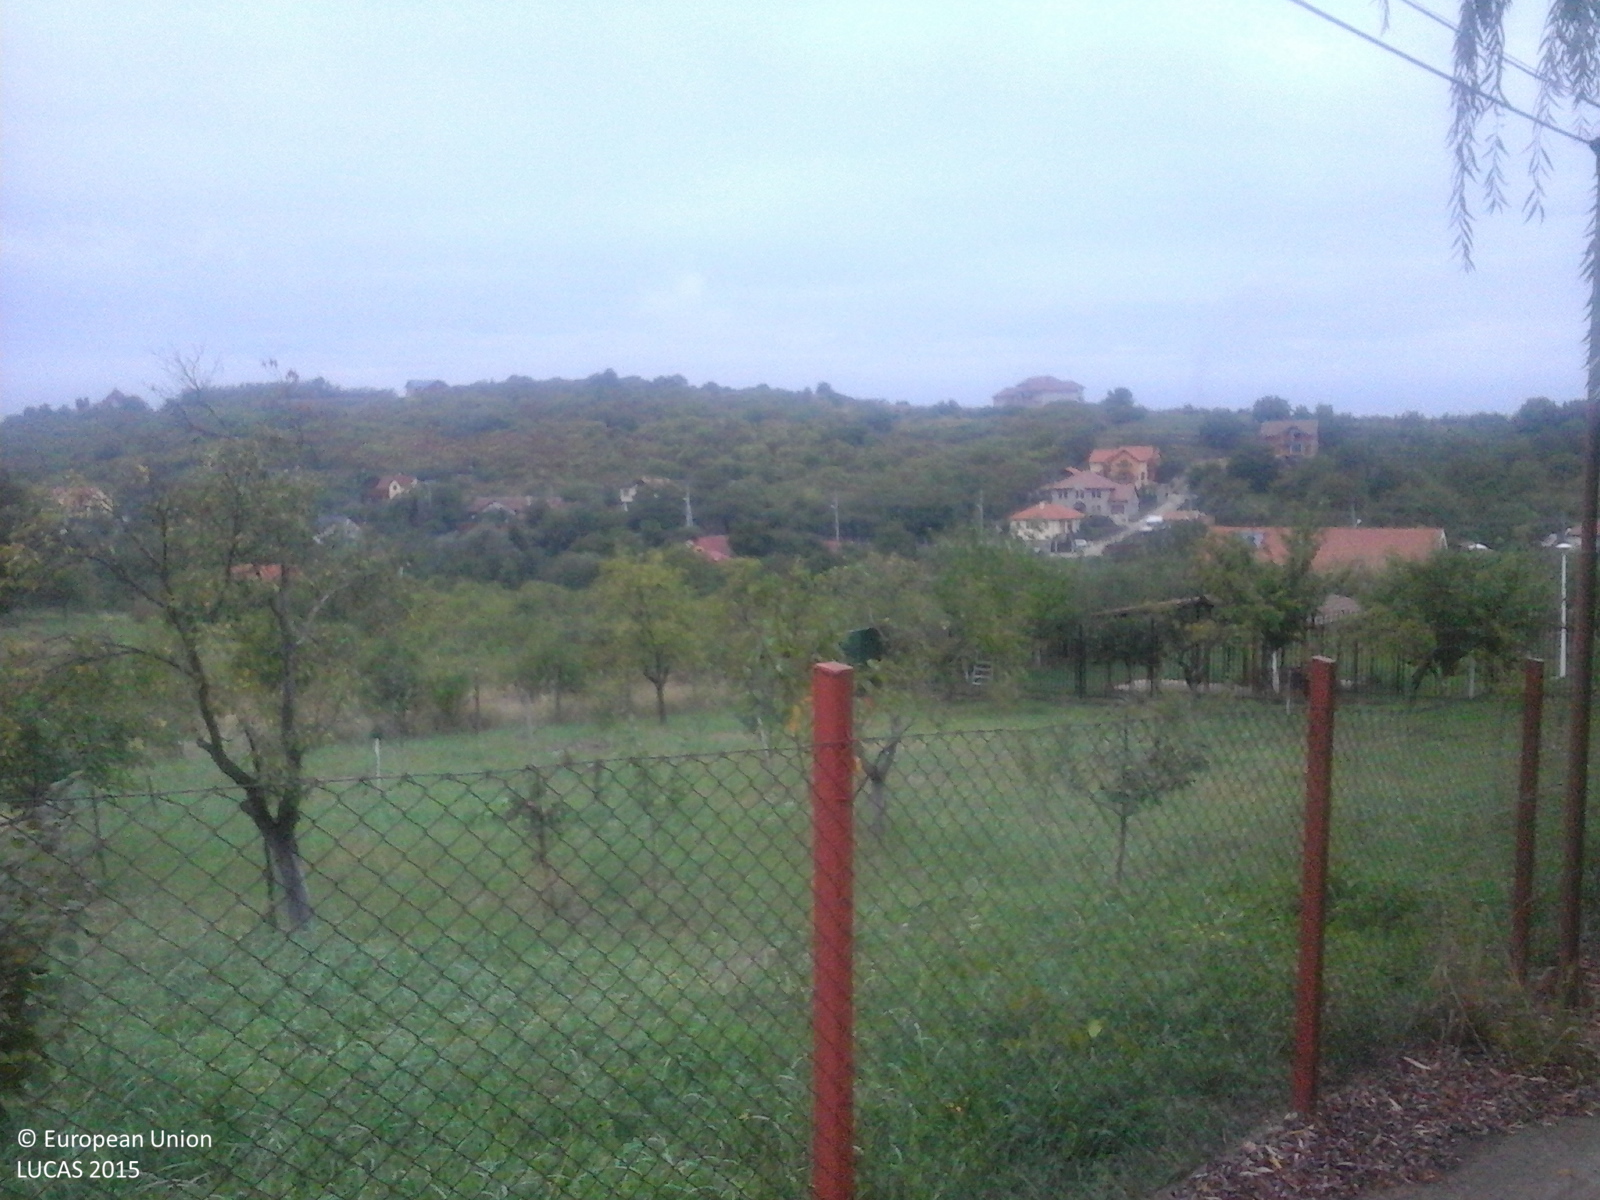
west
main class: Grassland
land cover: Spontaneously vegetated surfaces
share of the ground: > 75 %
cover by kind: herbaceous plants 100 %
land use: Residential
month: September
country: RO
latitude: 47.0602
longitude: 21.9620
